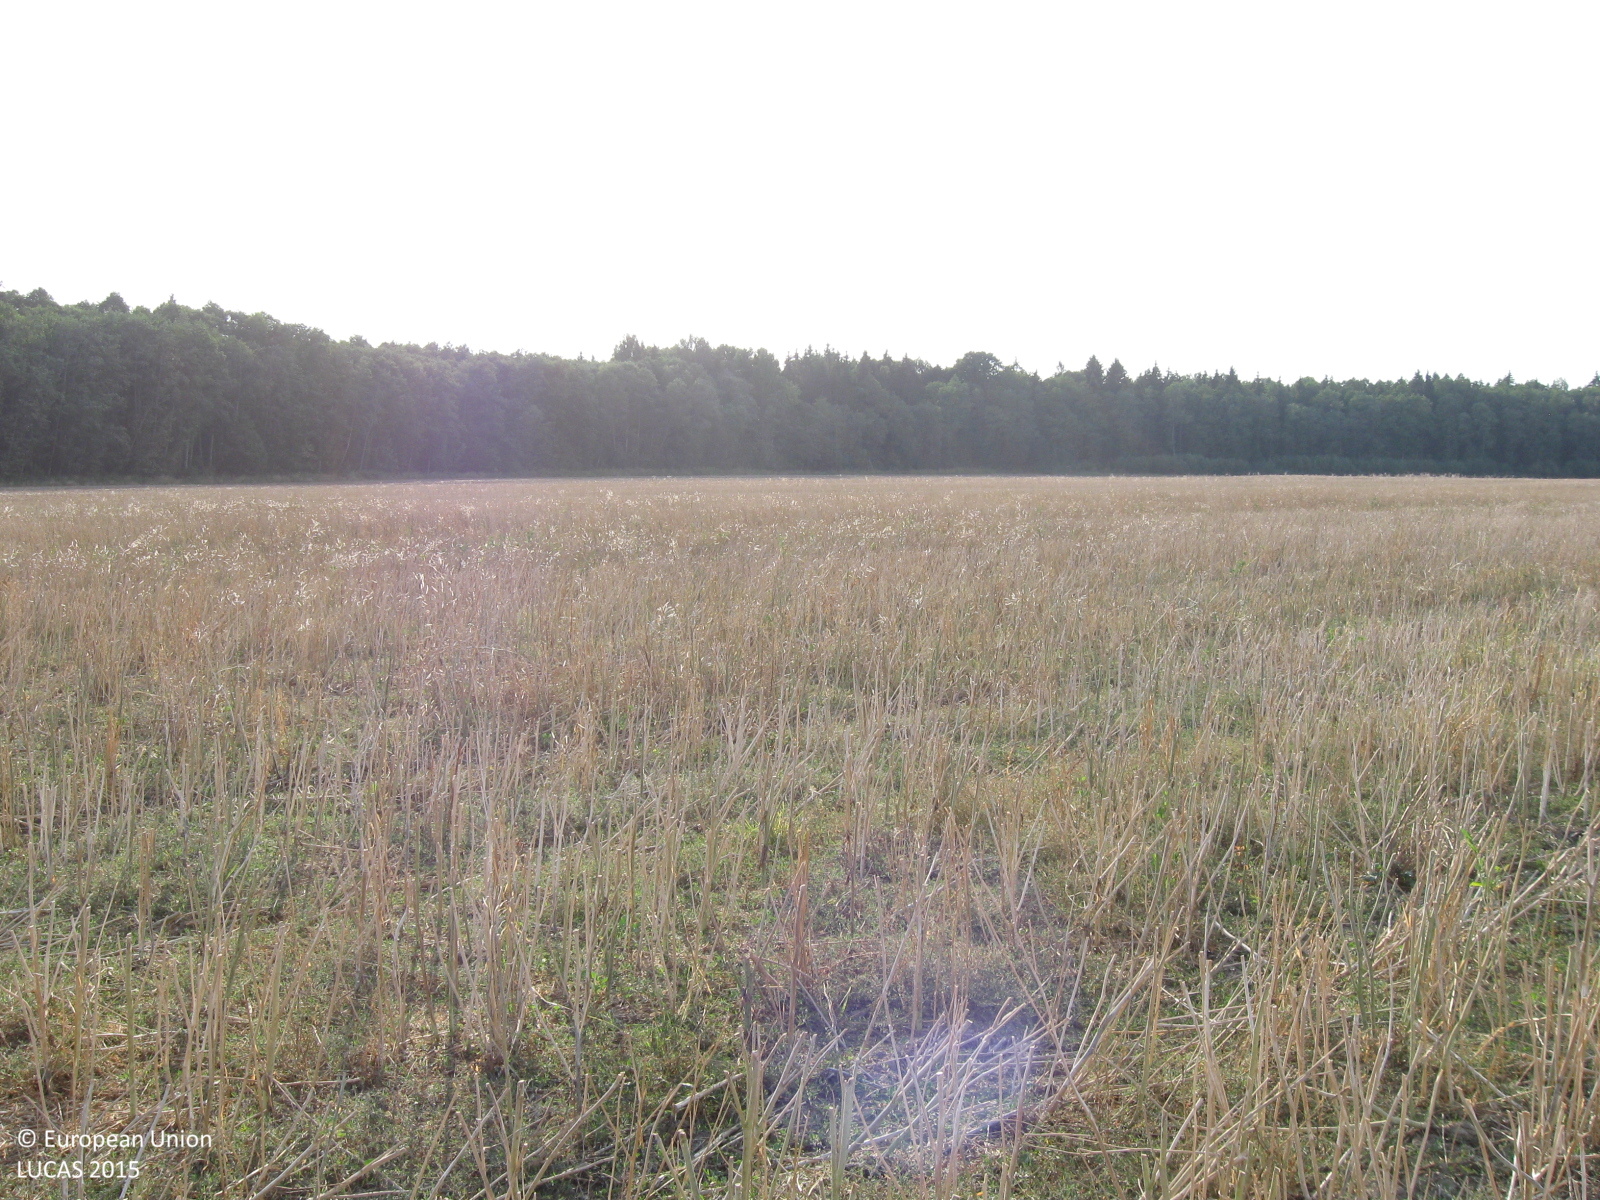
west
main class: Cropland
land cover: Rape and turnip rape
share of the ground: > 75 %
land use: Agriculture (excluding fallow land and kitchen gardens)
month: August
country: LT
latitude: 55.2812
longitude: 22.8674
